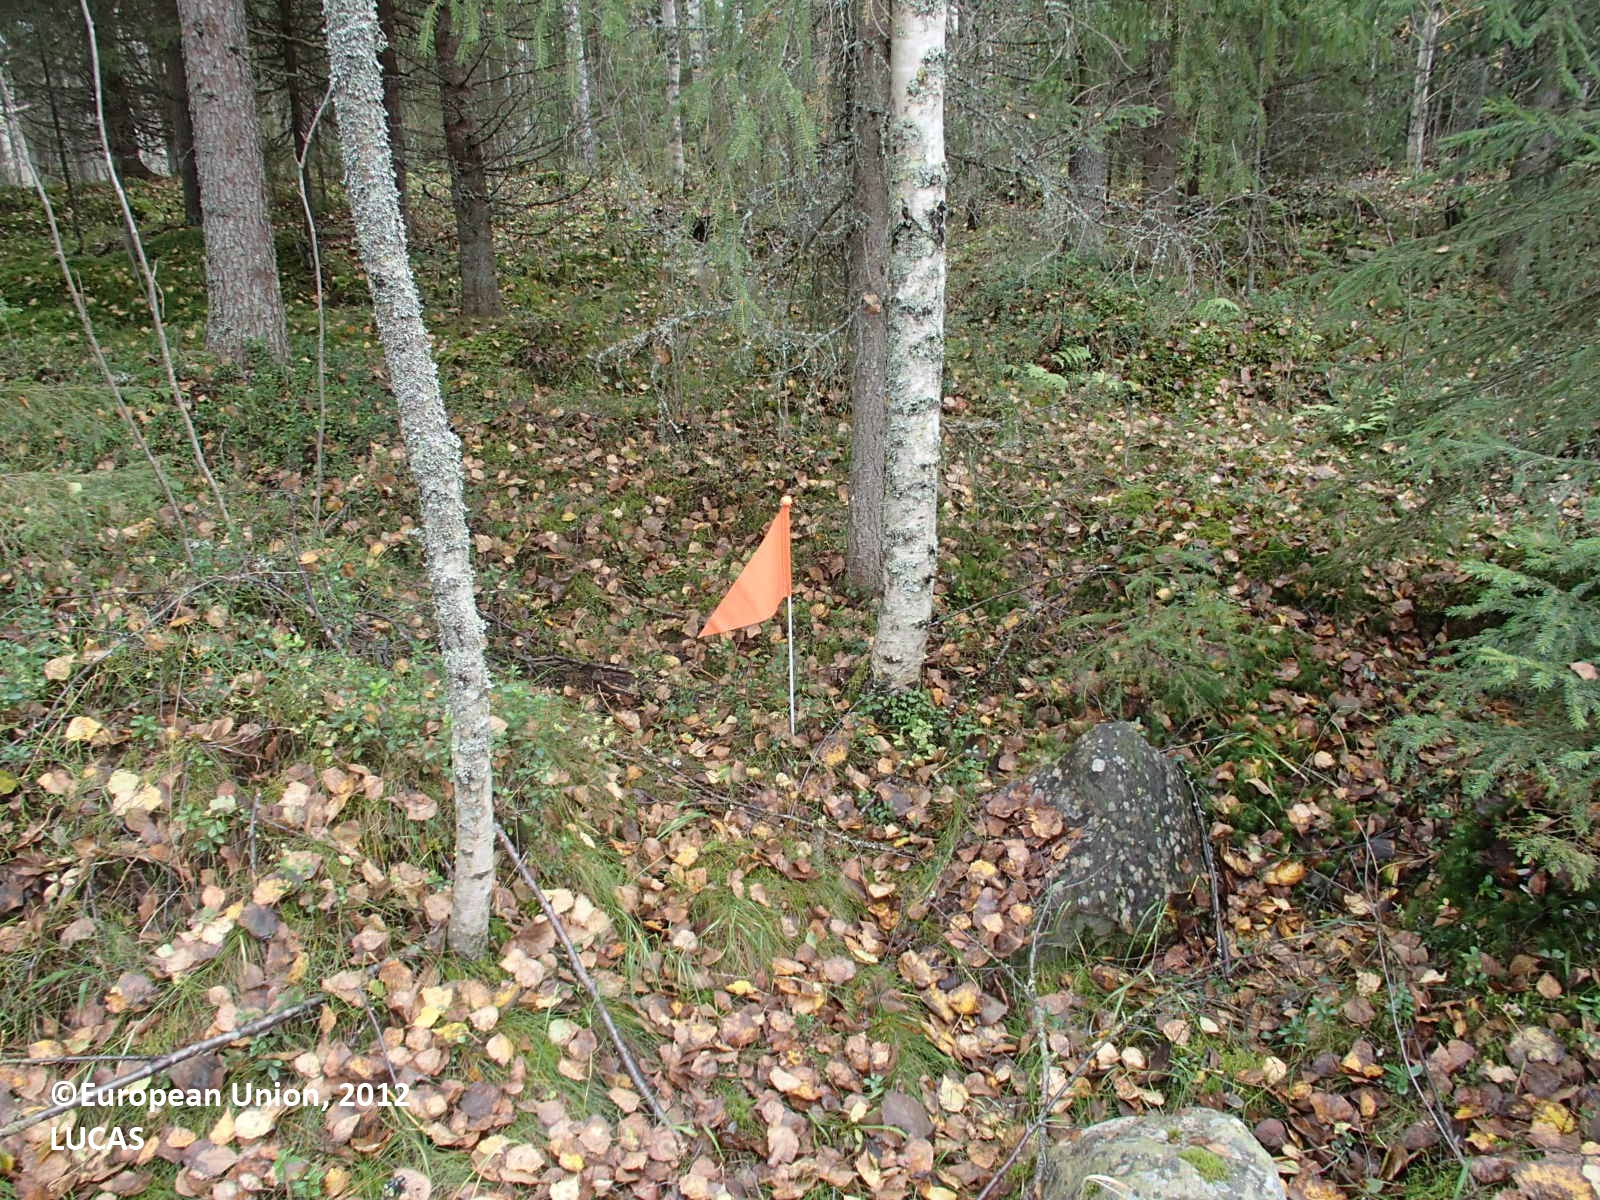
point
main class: Woodland
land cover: Spruce dominated mixed woodland
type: boreal forest
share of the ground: > 75 %
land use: Forestry
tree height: > 5 m
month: September
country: FI
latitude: 63.5111
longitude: 26.6285
